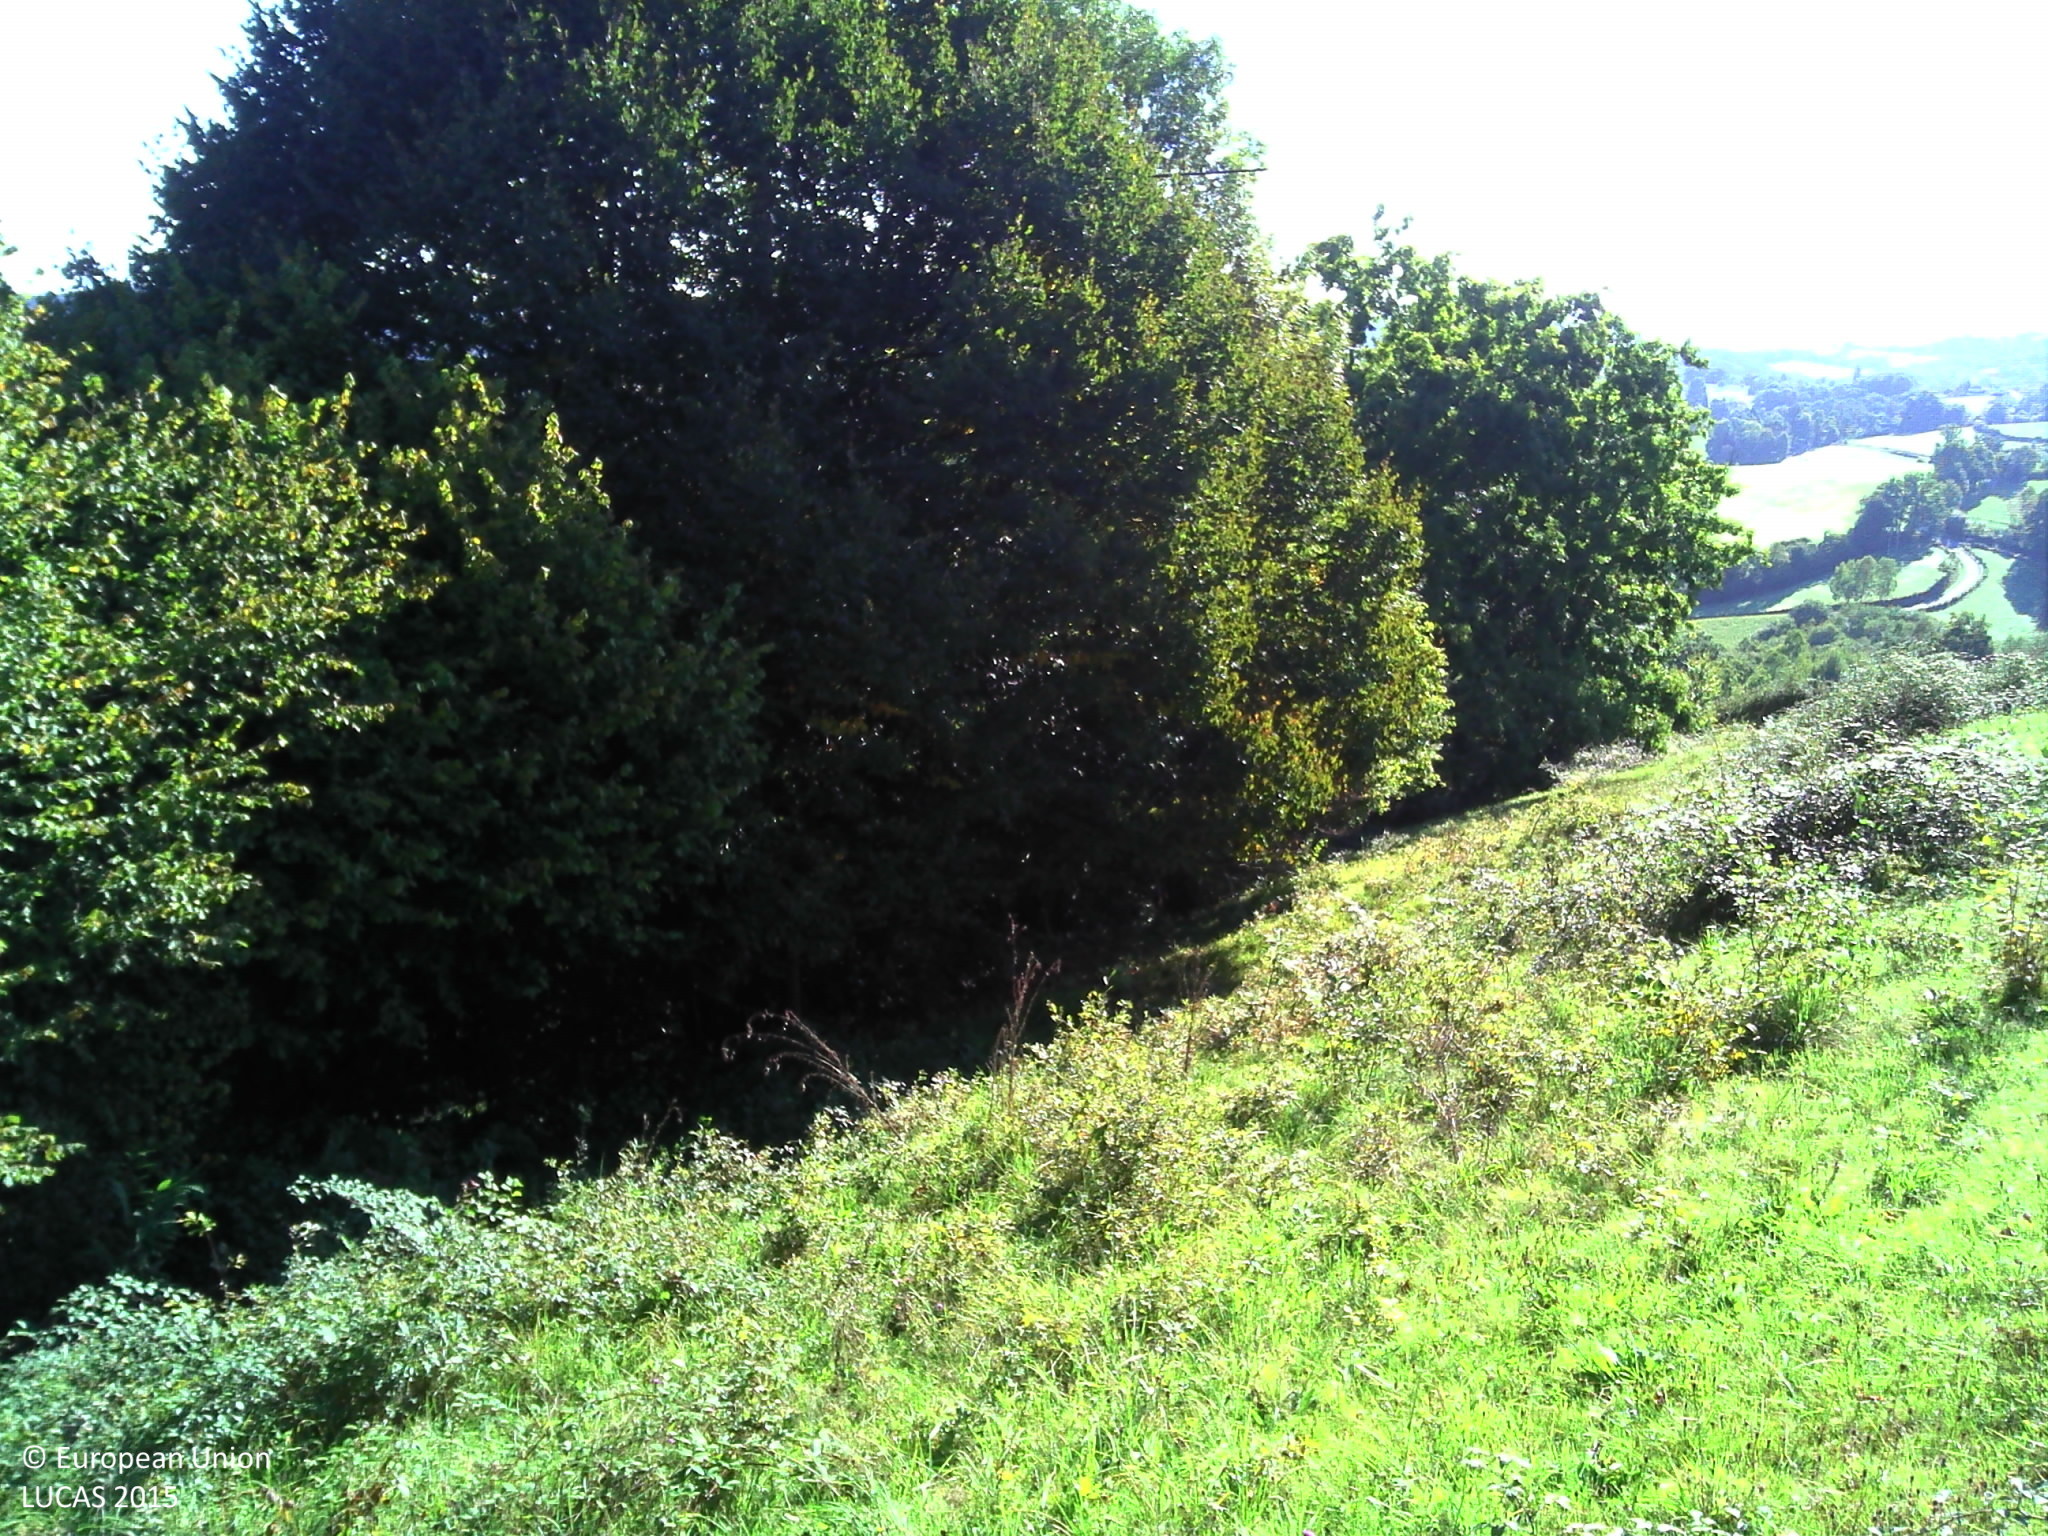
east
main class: Grassland
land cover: Grassland without tree/shrub cover
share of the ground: > 75 %
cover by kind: herbaceous plants 95 %, shrubs 5 %
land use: Agriculture (excluding fallow land and kitchen gardens)
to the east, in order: Grassland without tree/shrub cover; Fences; Broadleaved woodland; Tracks; Grassland without tree/shrub cover; Shrubland with sparse tree cover; Spontaneously vegetated surfaces; Fences; Spontaneously vegetated surfaces; Grassland without tree/shrub cover; Broadleaved woodland; Fences; Tracks; Broadleaved woodland
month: September
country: FR
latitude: 43.1771
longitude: -0.3518
